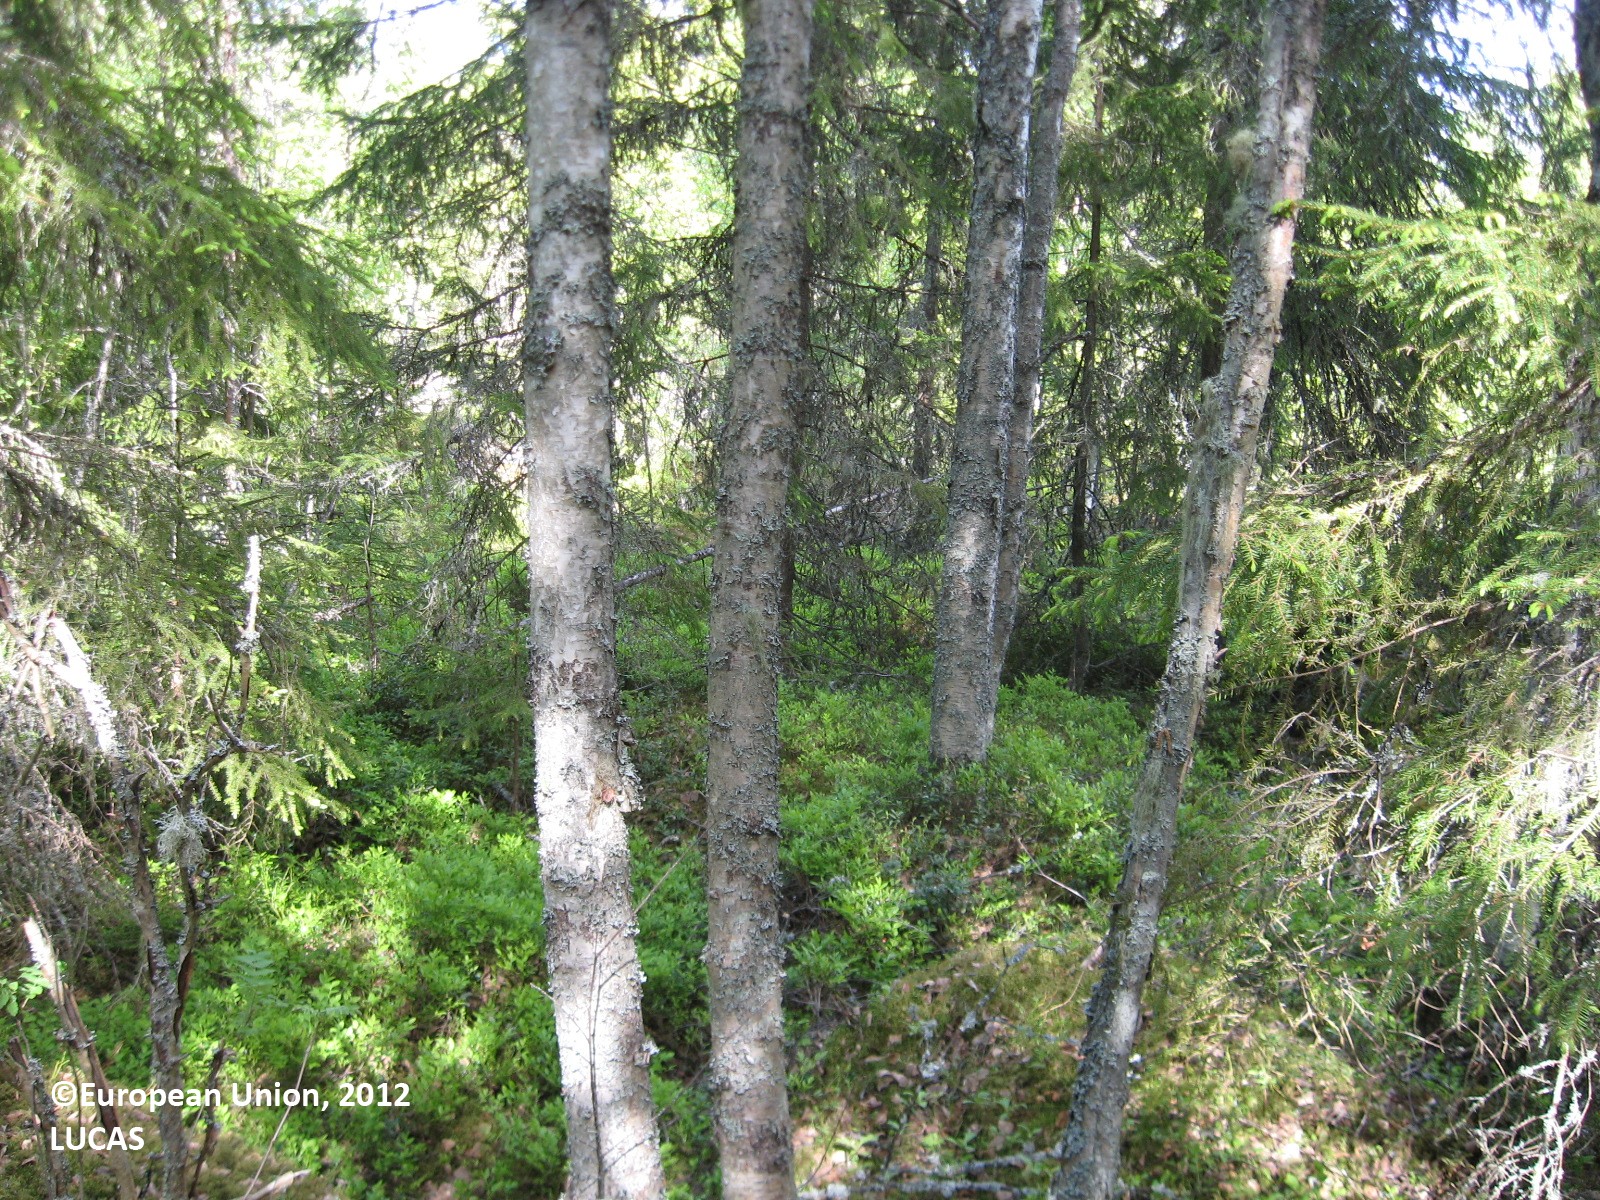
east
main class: Woodland
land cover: Spruce dominated mixed woodland
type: boreal forest
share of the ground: > 75 %
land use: Forestry
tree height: > 5 m
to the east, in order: Spruce dominated mixed woodland; Spruce dominated coniferous woodland; Spruce dominated mixed woodland; Other mixed woodland; Tracks; Other mixed woodland; Artificial constructions in urban areas; Other mixed woodland; Spontaneously vegetated surfaces; Ditches and canals; Grass margins; Ditches and canals; Electric lines; Oats
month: June
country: FI
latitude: 63.2157
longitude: 21.9171
